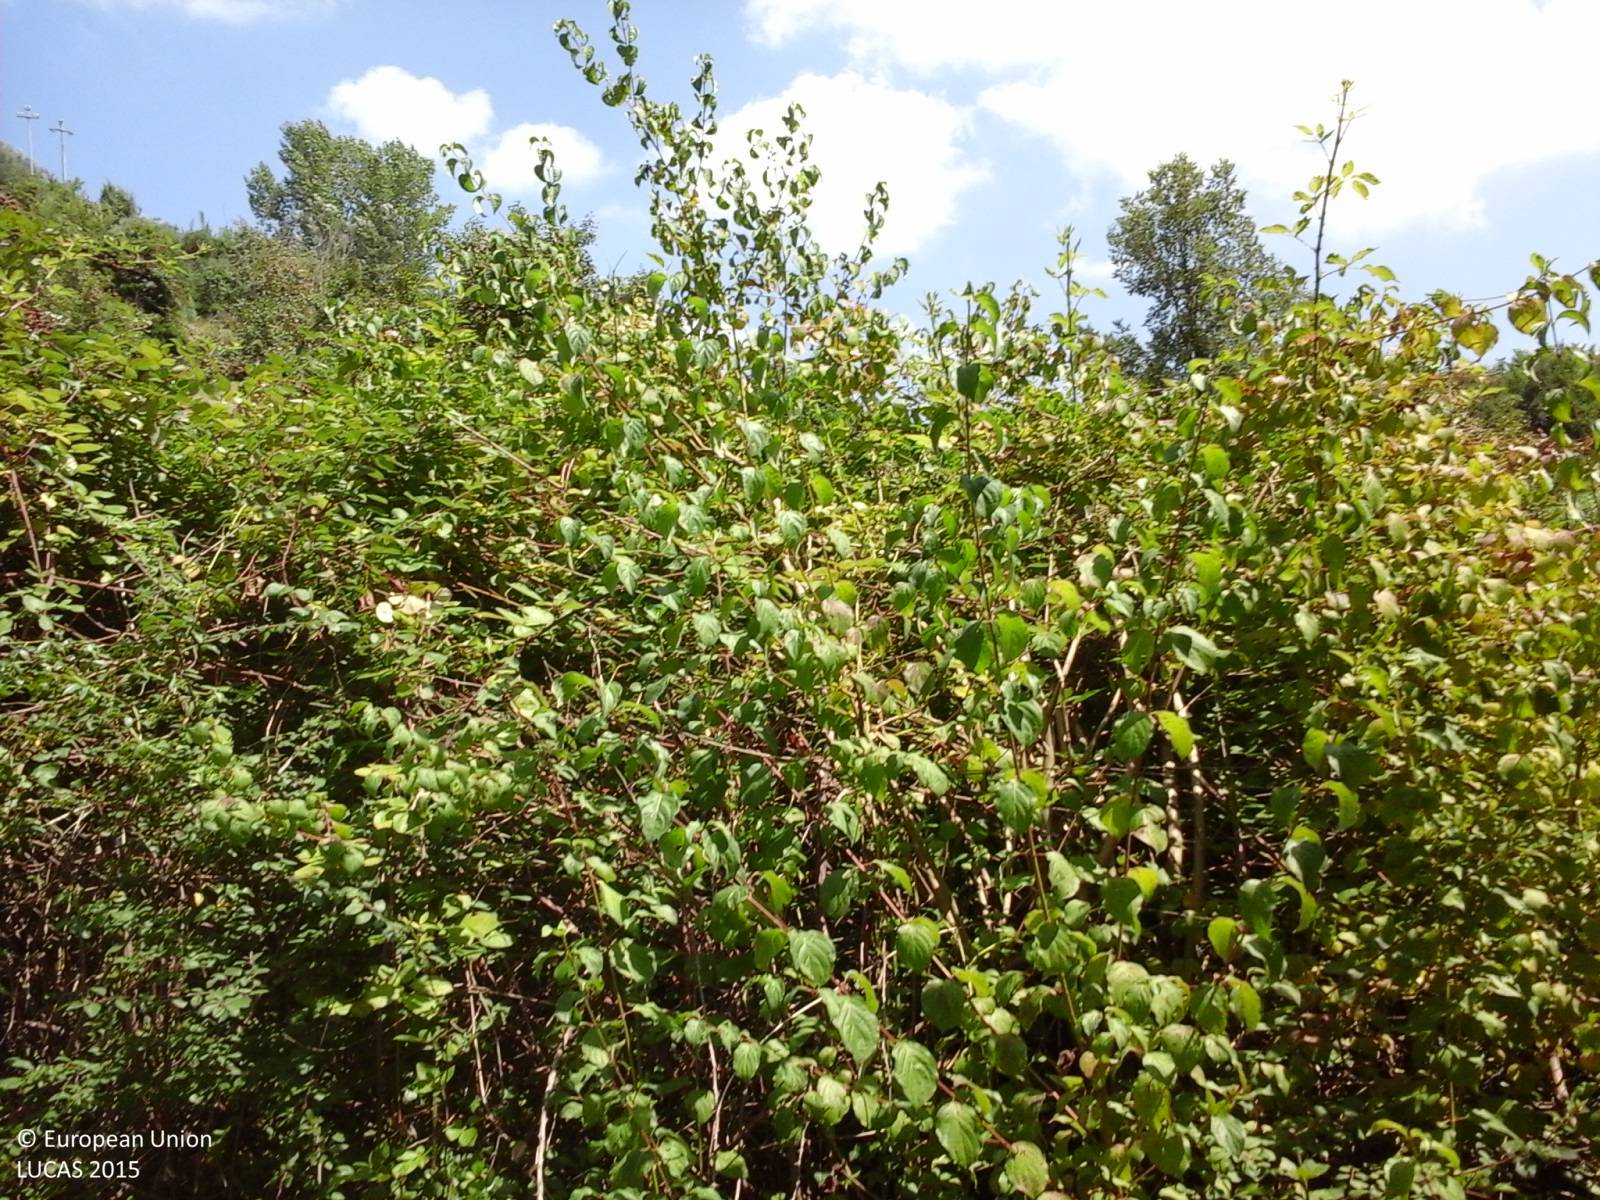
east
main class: Woodland
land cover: Broadleaved woodland
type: thermophilous deciduous forest
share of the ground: > 75 %
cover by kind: broadleaved forest trees 70 %, shrubs 30 %
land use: Semi-natural and natural areas not in use
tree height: > 5 m
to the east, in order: Broadleaved woodland; Ditches and canals; Broadleaved woodland; Tracks; Abandoned hedges; Grassland without tree/shrub cover; Shrubland without tree cover; Electric lines; Grassland without tree/shrub cover; Shrubland without tree cover; Grassland without tree/shrub cover; Tracks; Broadleaved woodland
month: July
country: IT
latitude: 42.2232
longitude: 12.5957
